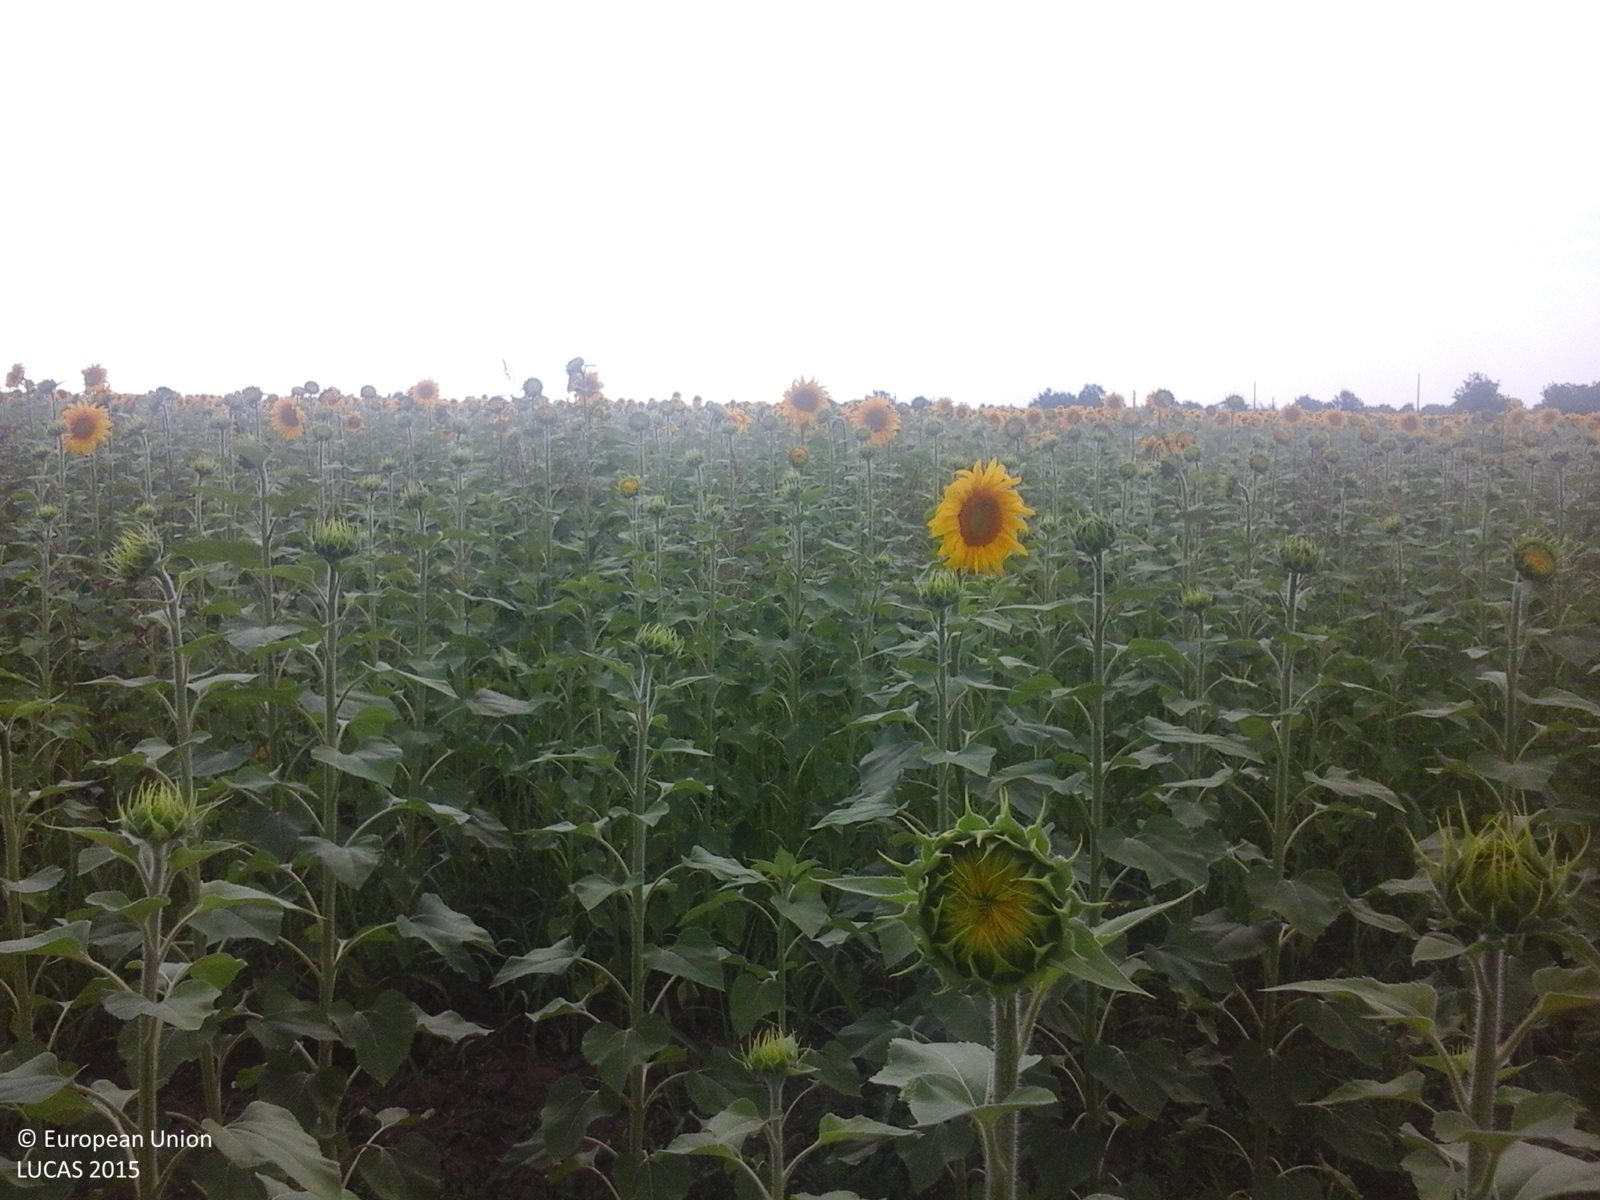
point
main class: Cropland
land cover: Sunflower
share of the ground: > 75 %
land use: Agriculture (excluding fallow land and kitchen gardens)
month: July
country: RO
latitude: 43.8308
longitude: 24.8069
